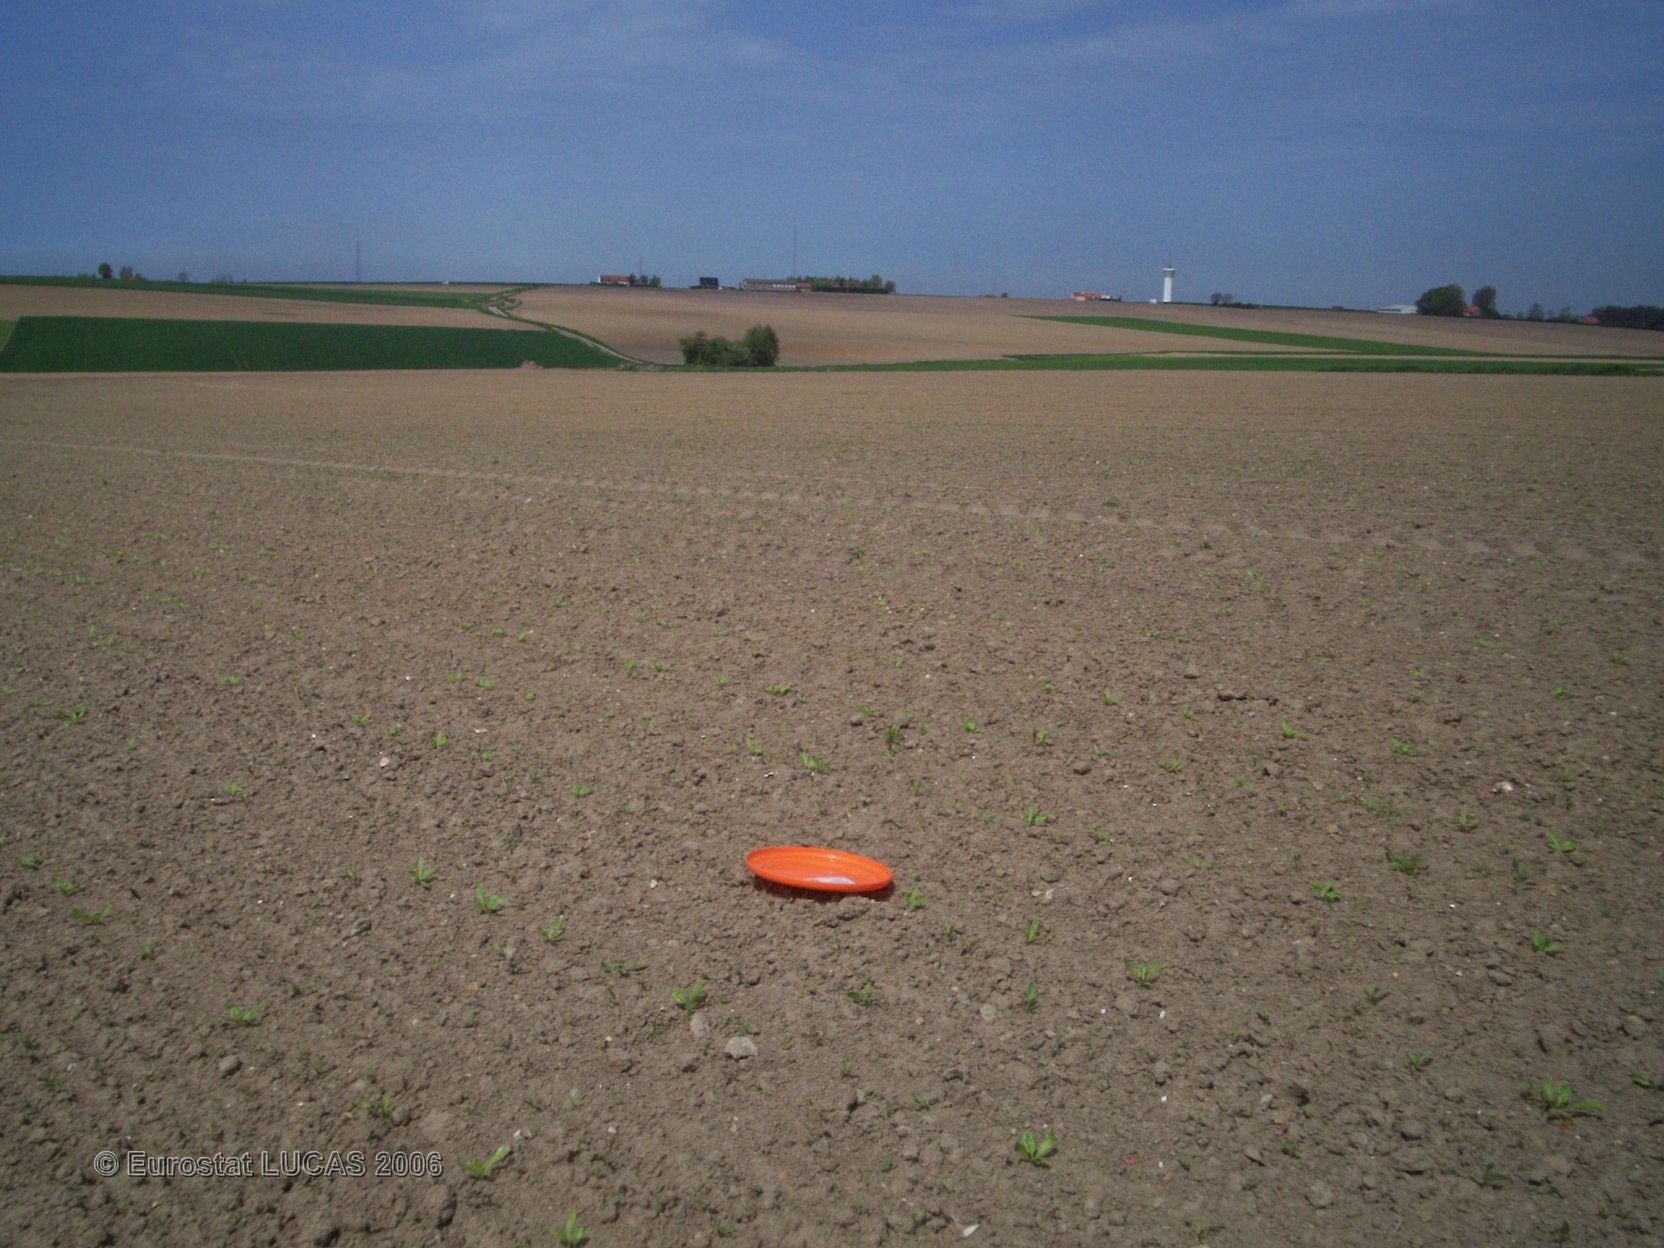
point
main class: Cropland
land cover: Sugar beet
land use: Agriculture (excluding fallow land and kitchen gardens)
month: May
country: FR
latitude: 50.9203
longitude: 2.3473
